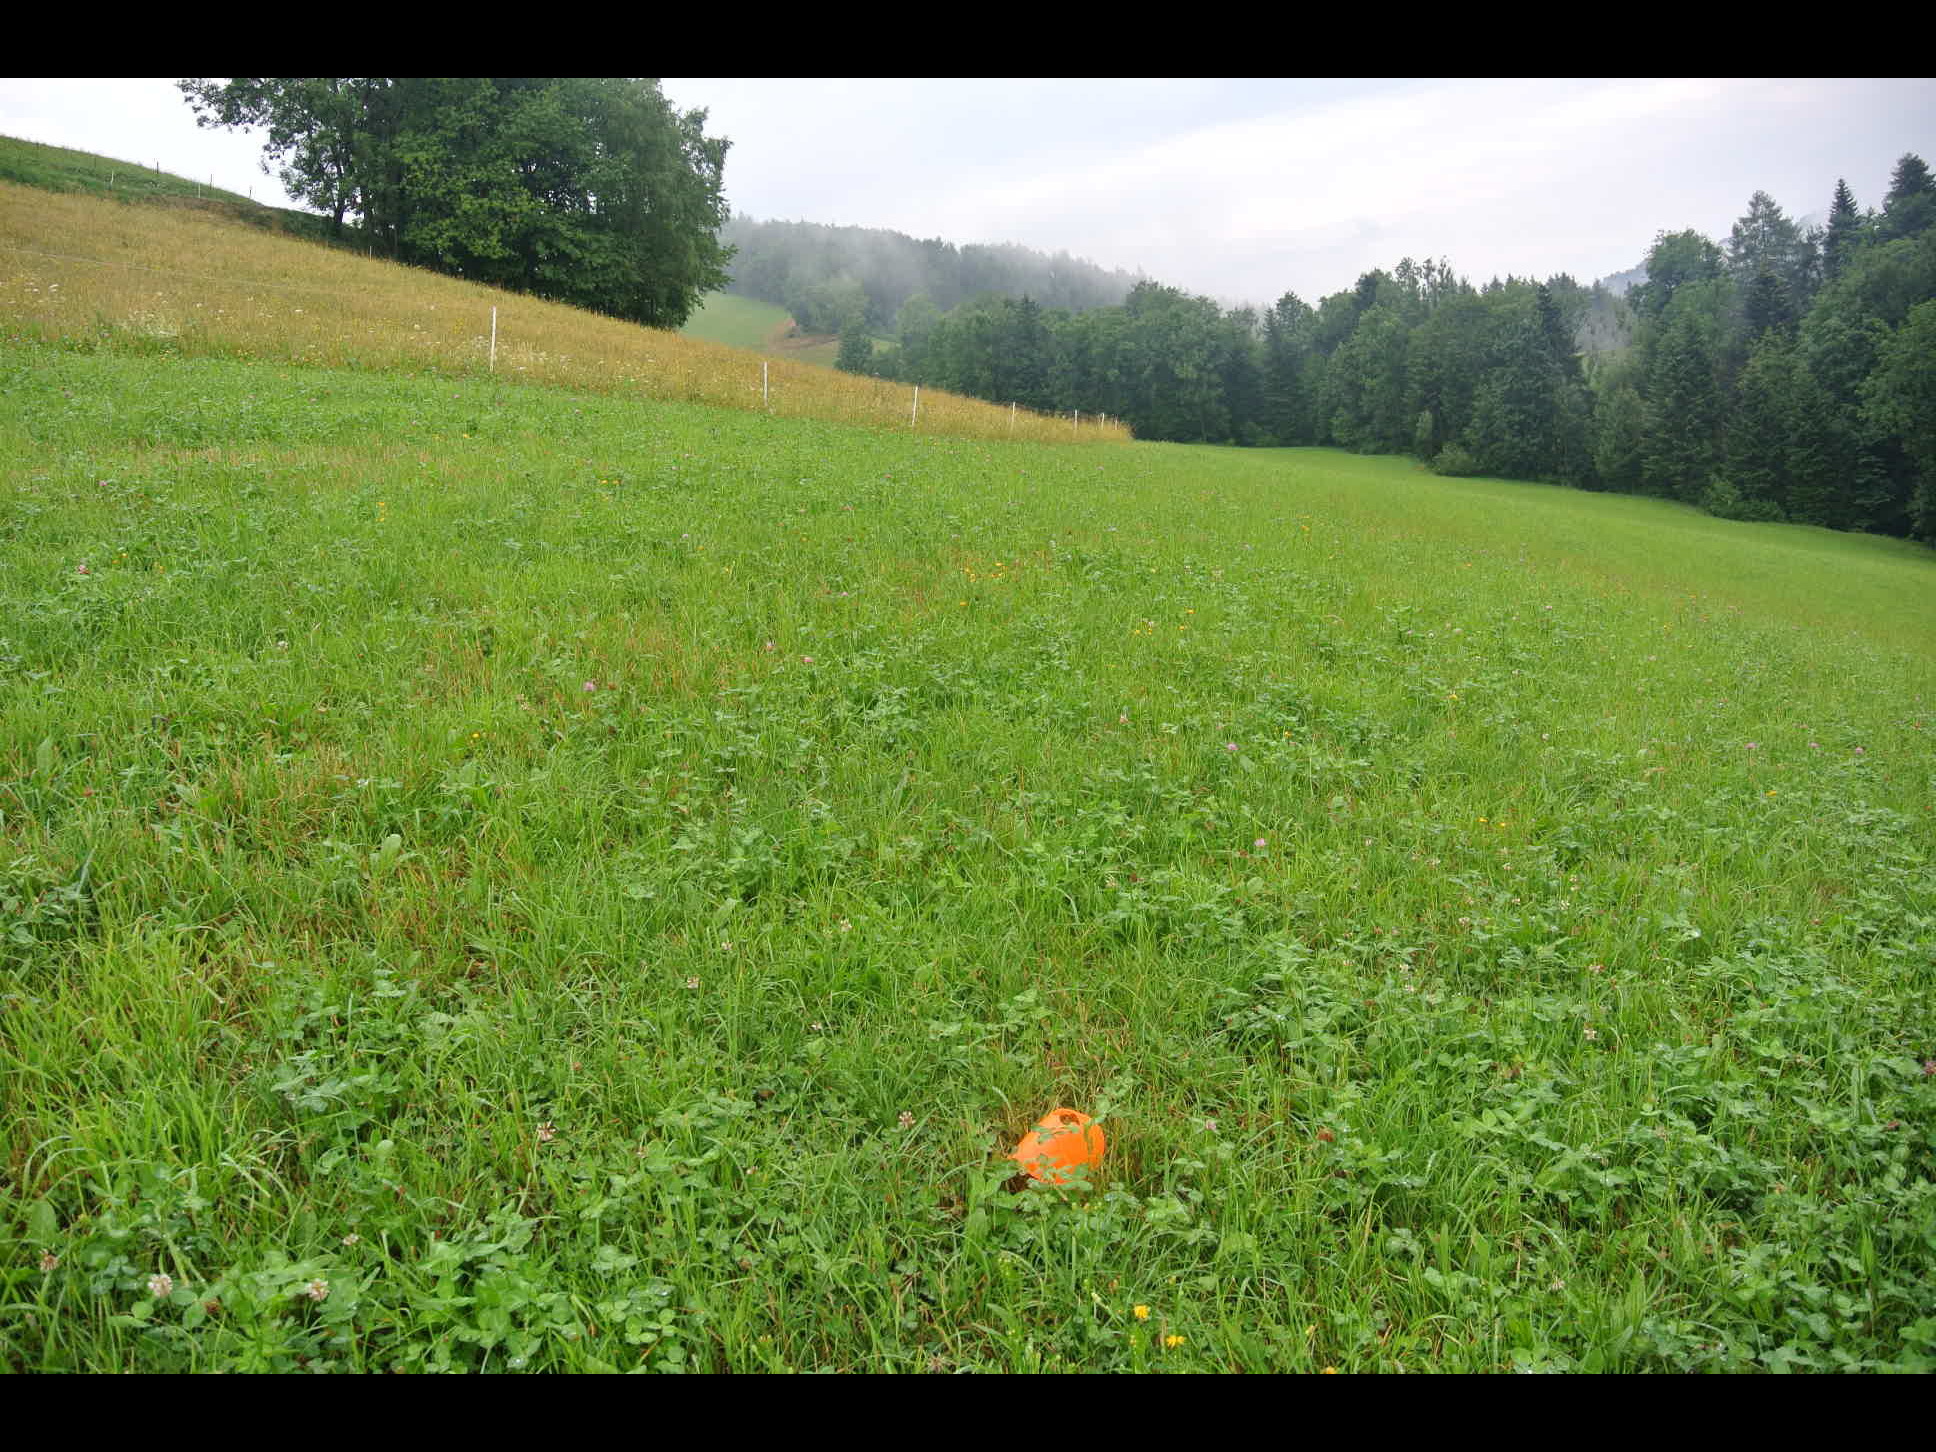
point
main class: Grassland
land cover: Grassland without tree/shrub cover
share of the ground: > 75 %
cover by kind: herbaceous plants 100 %
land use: Agriculture (excluding fallow land and kitchen gardens)
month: July
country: AT
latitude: 47.4730
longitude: 16.1725
